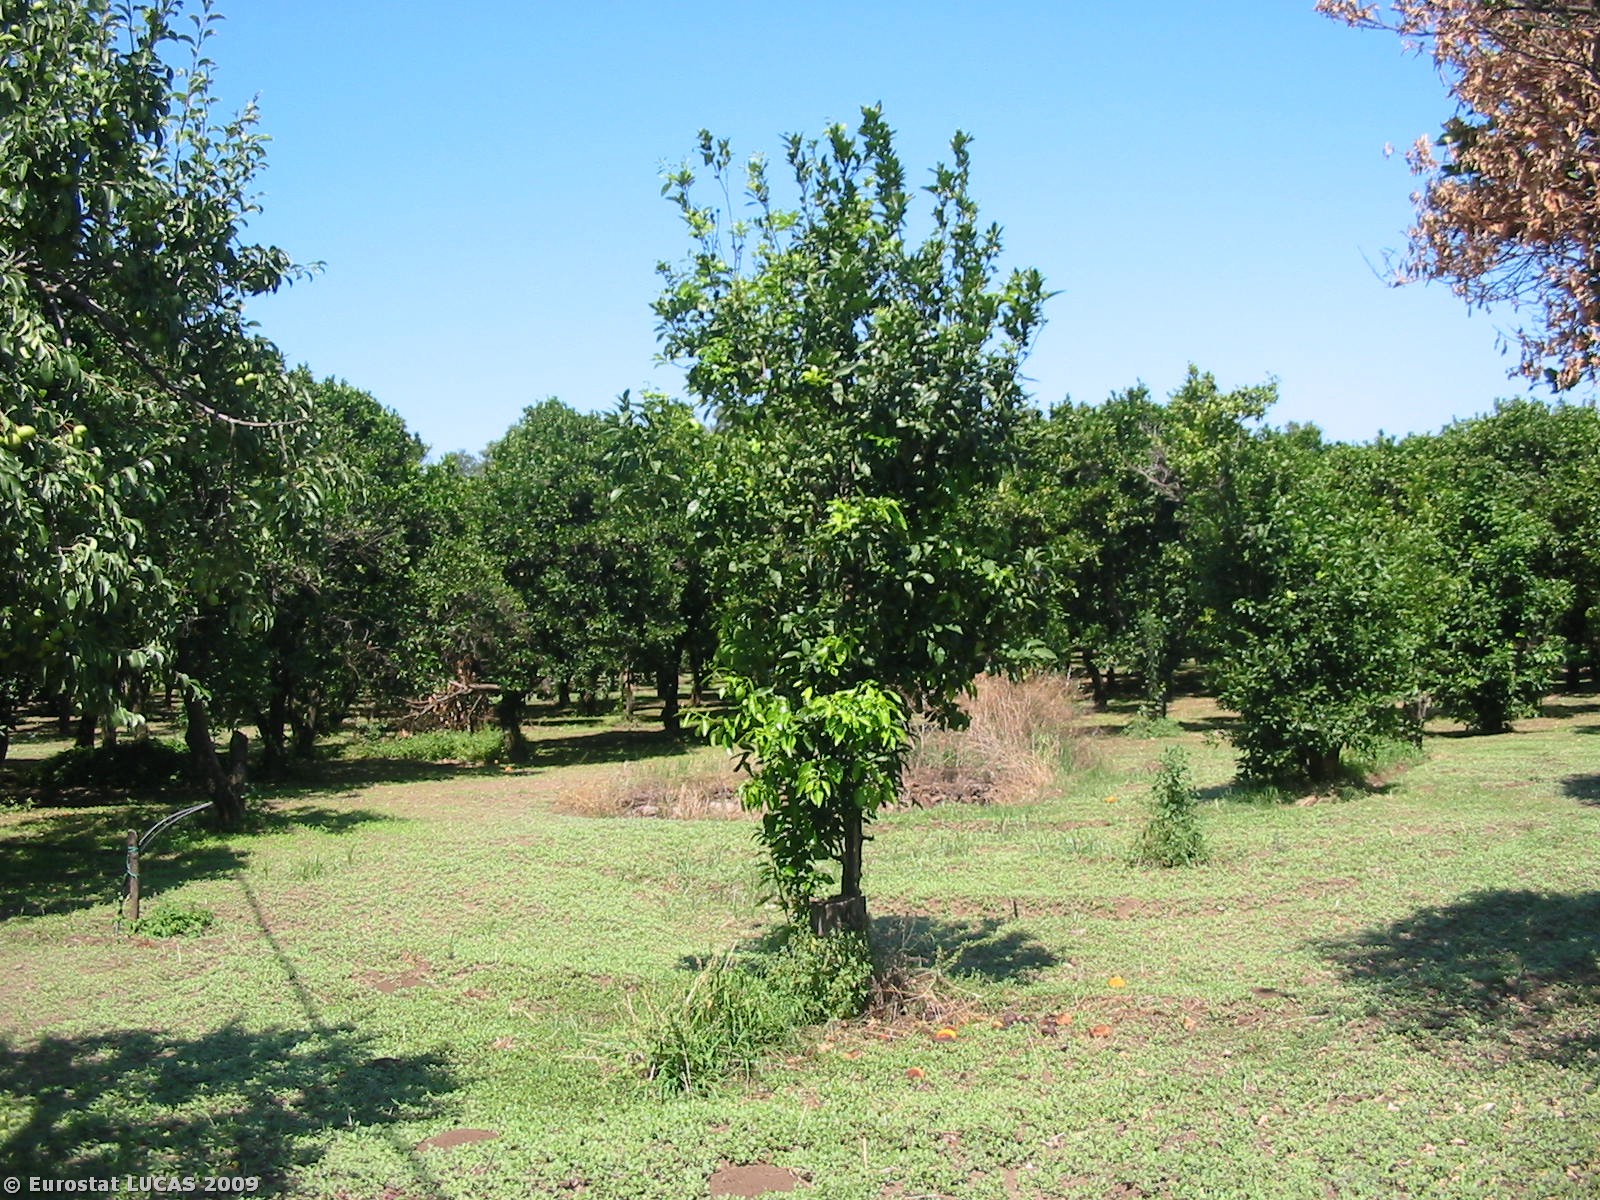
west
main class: Cropland
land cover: Oranges
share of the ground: > 75 %
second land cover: Spontaneously vegetated surfaces
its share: 50 - 75 %
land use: Agriculture (excluding fallow land and kitchen gardens)
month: July
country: IT
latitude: 38.4170
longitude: 15.9321
